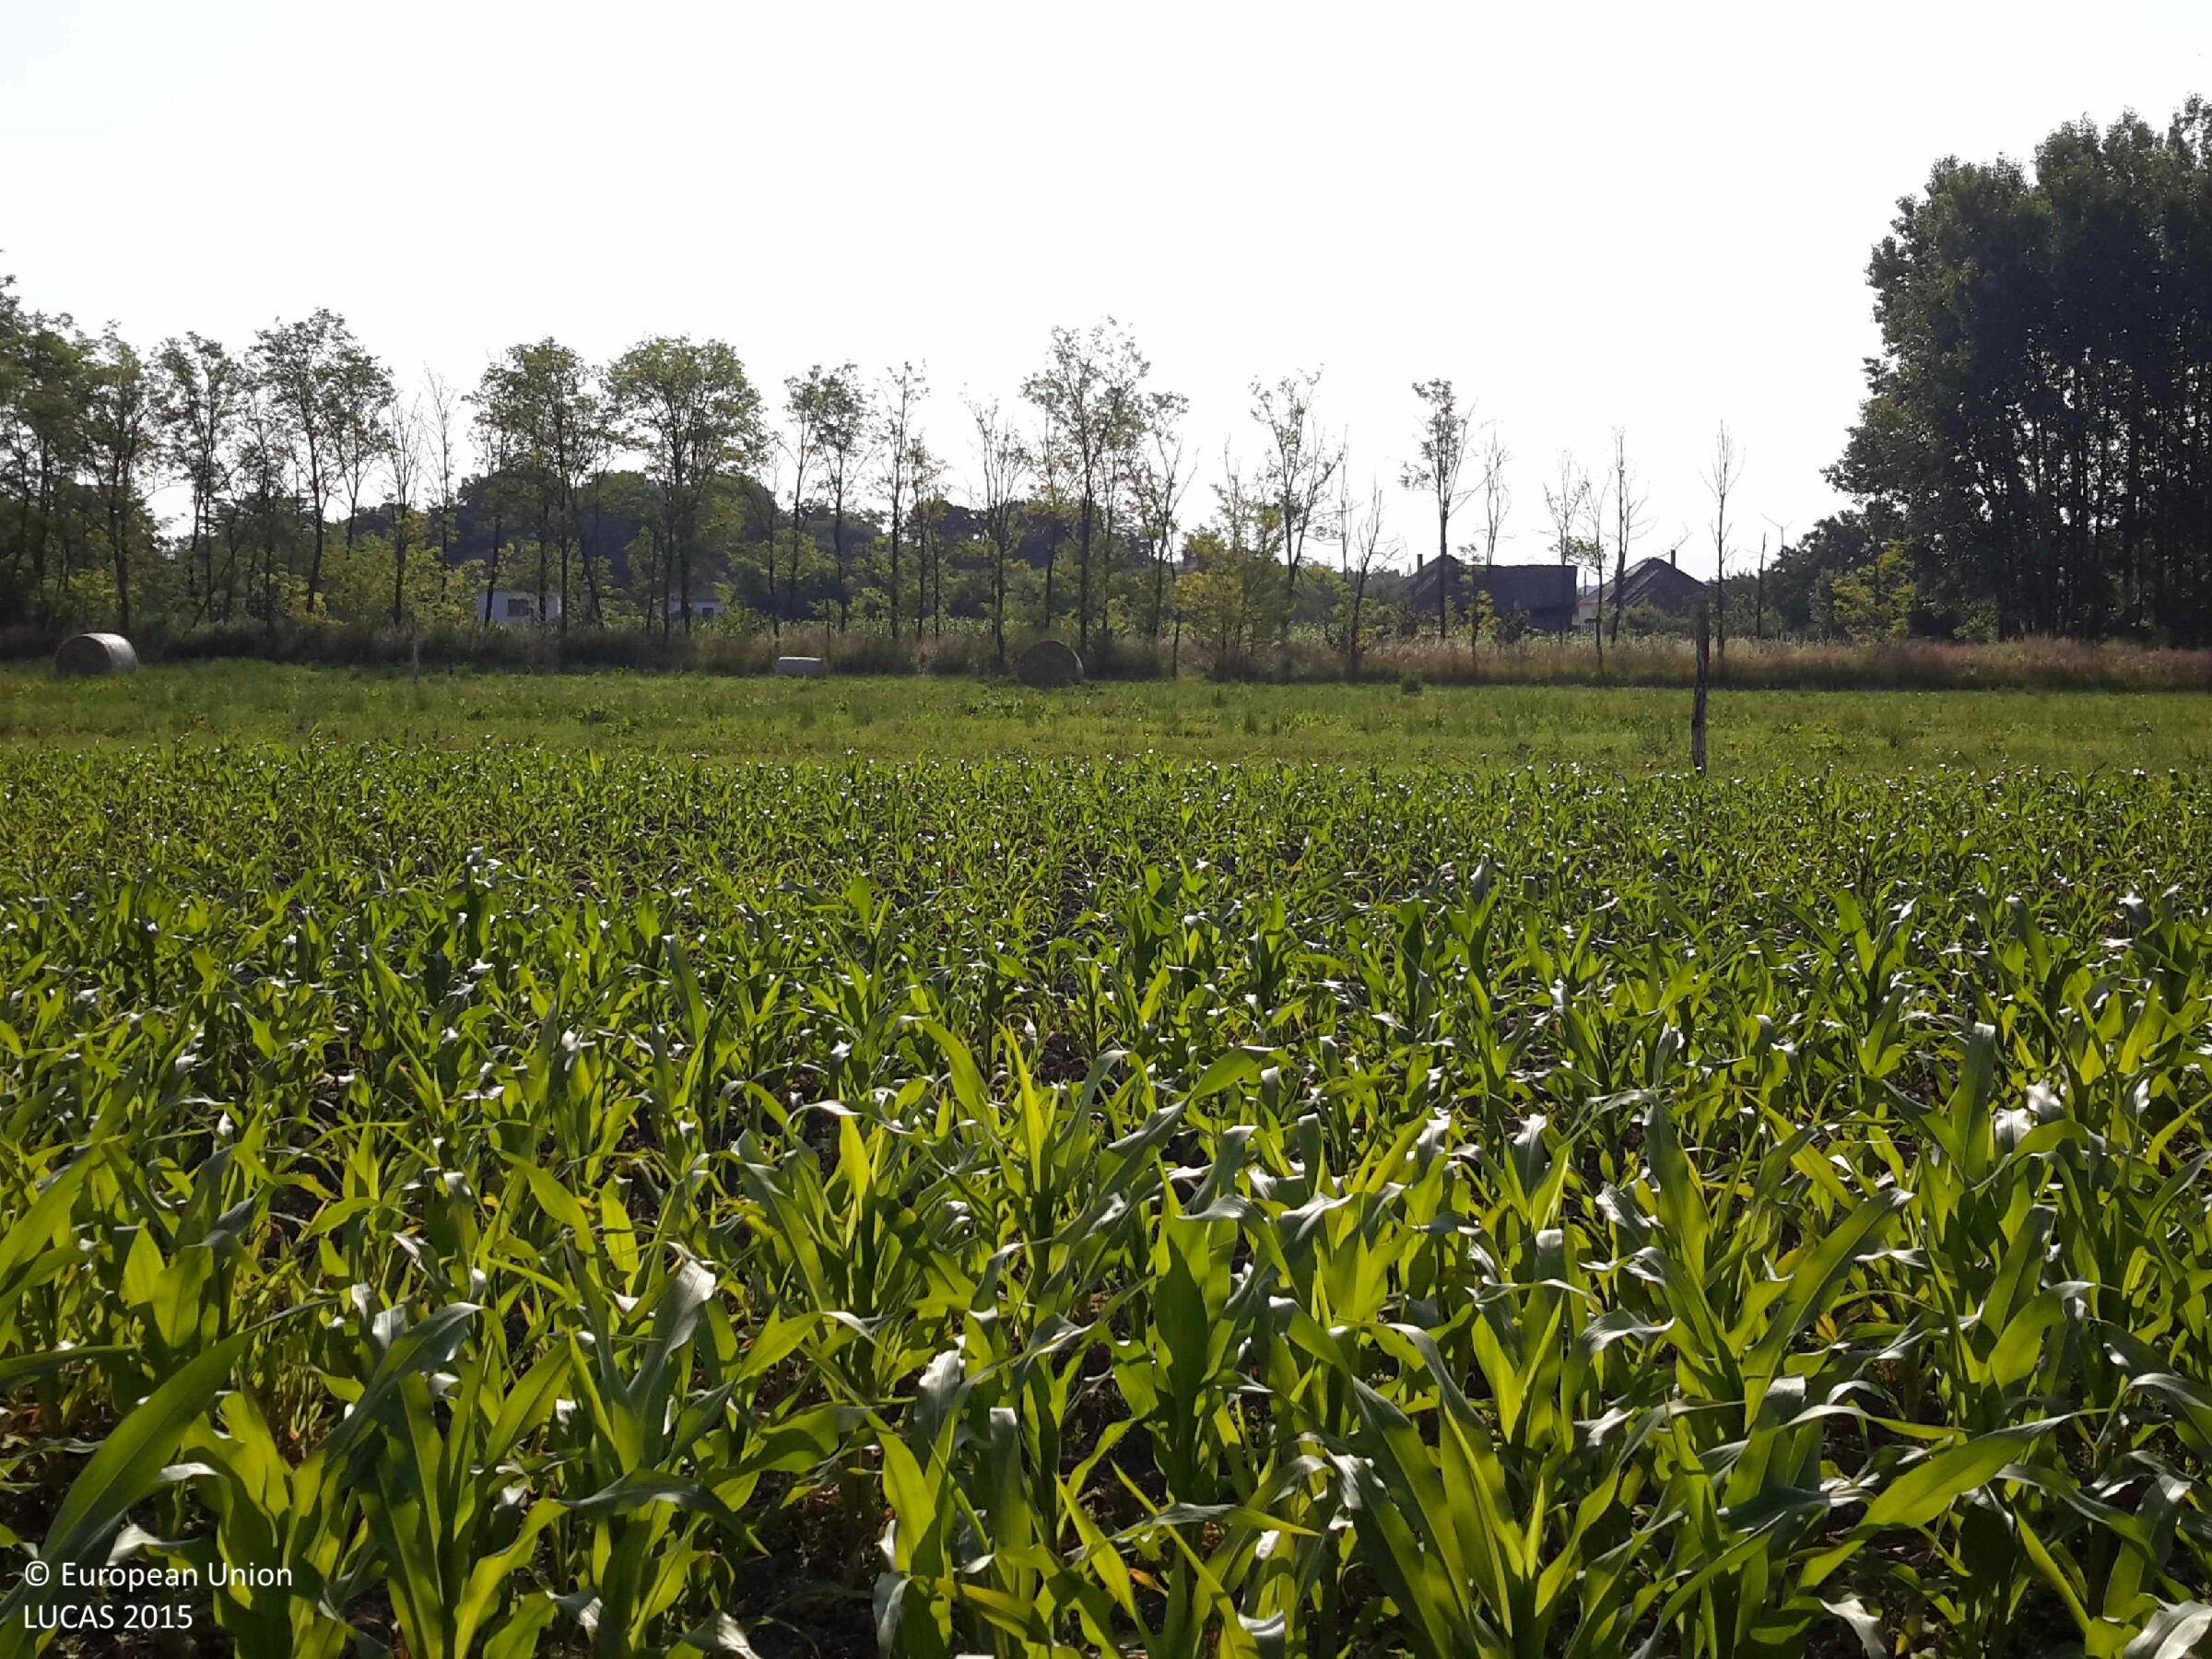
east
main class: Cropland
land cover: Maize
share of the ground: 50 - 75 %
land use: Agriculture (excluding fallow land and kitchen gardens)
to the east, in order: Maize; Grassland without tree/shrub cover; Broadleaved woodland; Grassland without tree/shrub cover; Maize; Grassland without tree/shrub cover; Artificial constructions in urban areas
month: July
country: HU
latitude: 47.4419
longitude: 17.5268
